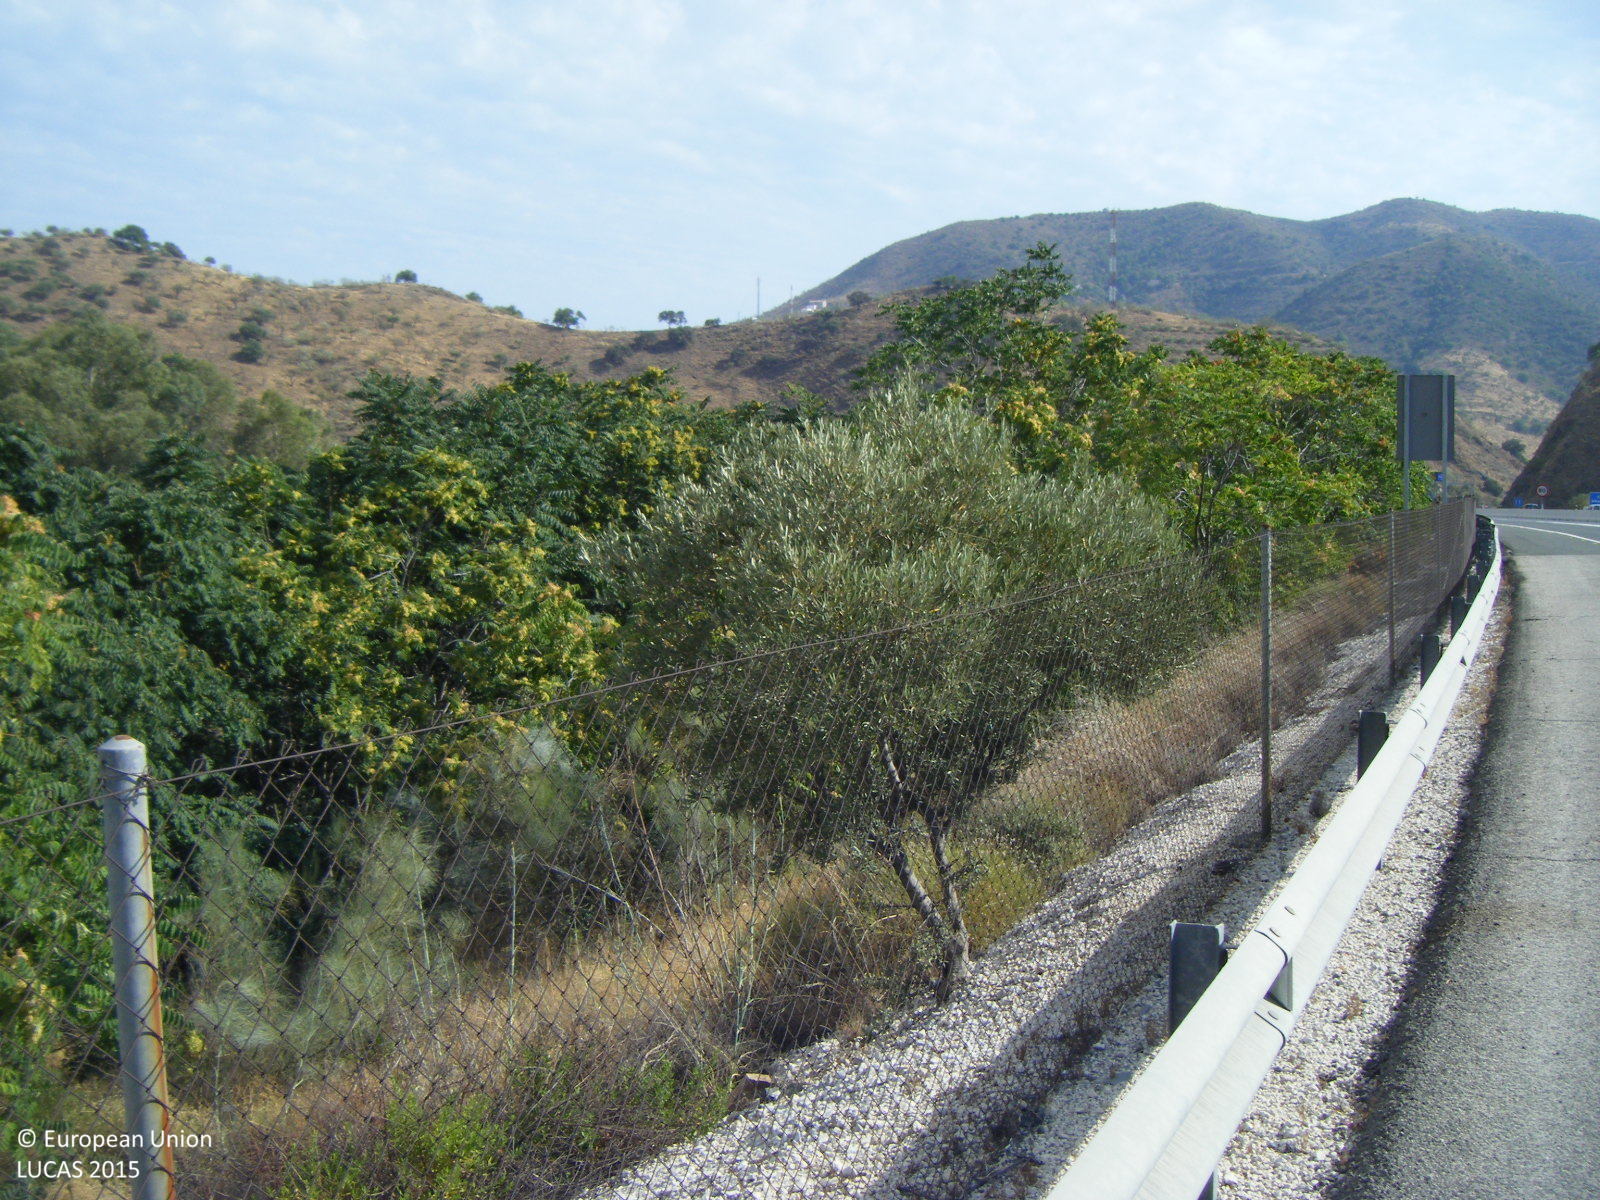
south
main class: Cropland
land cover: Olive groves
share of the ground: 10 - 25 %
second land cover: Spontaneously vegetated surfaces
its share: > 75 %
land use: Agriculture (excluding fallow land and kitchen gardens)
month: July
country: ES
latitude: 36.8226
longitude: -4.4429
